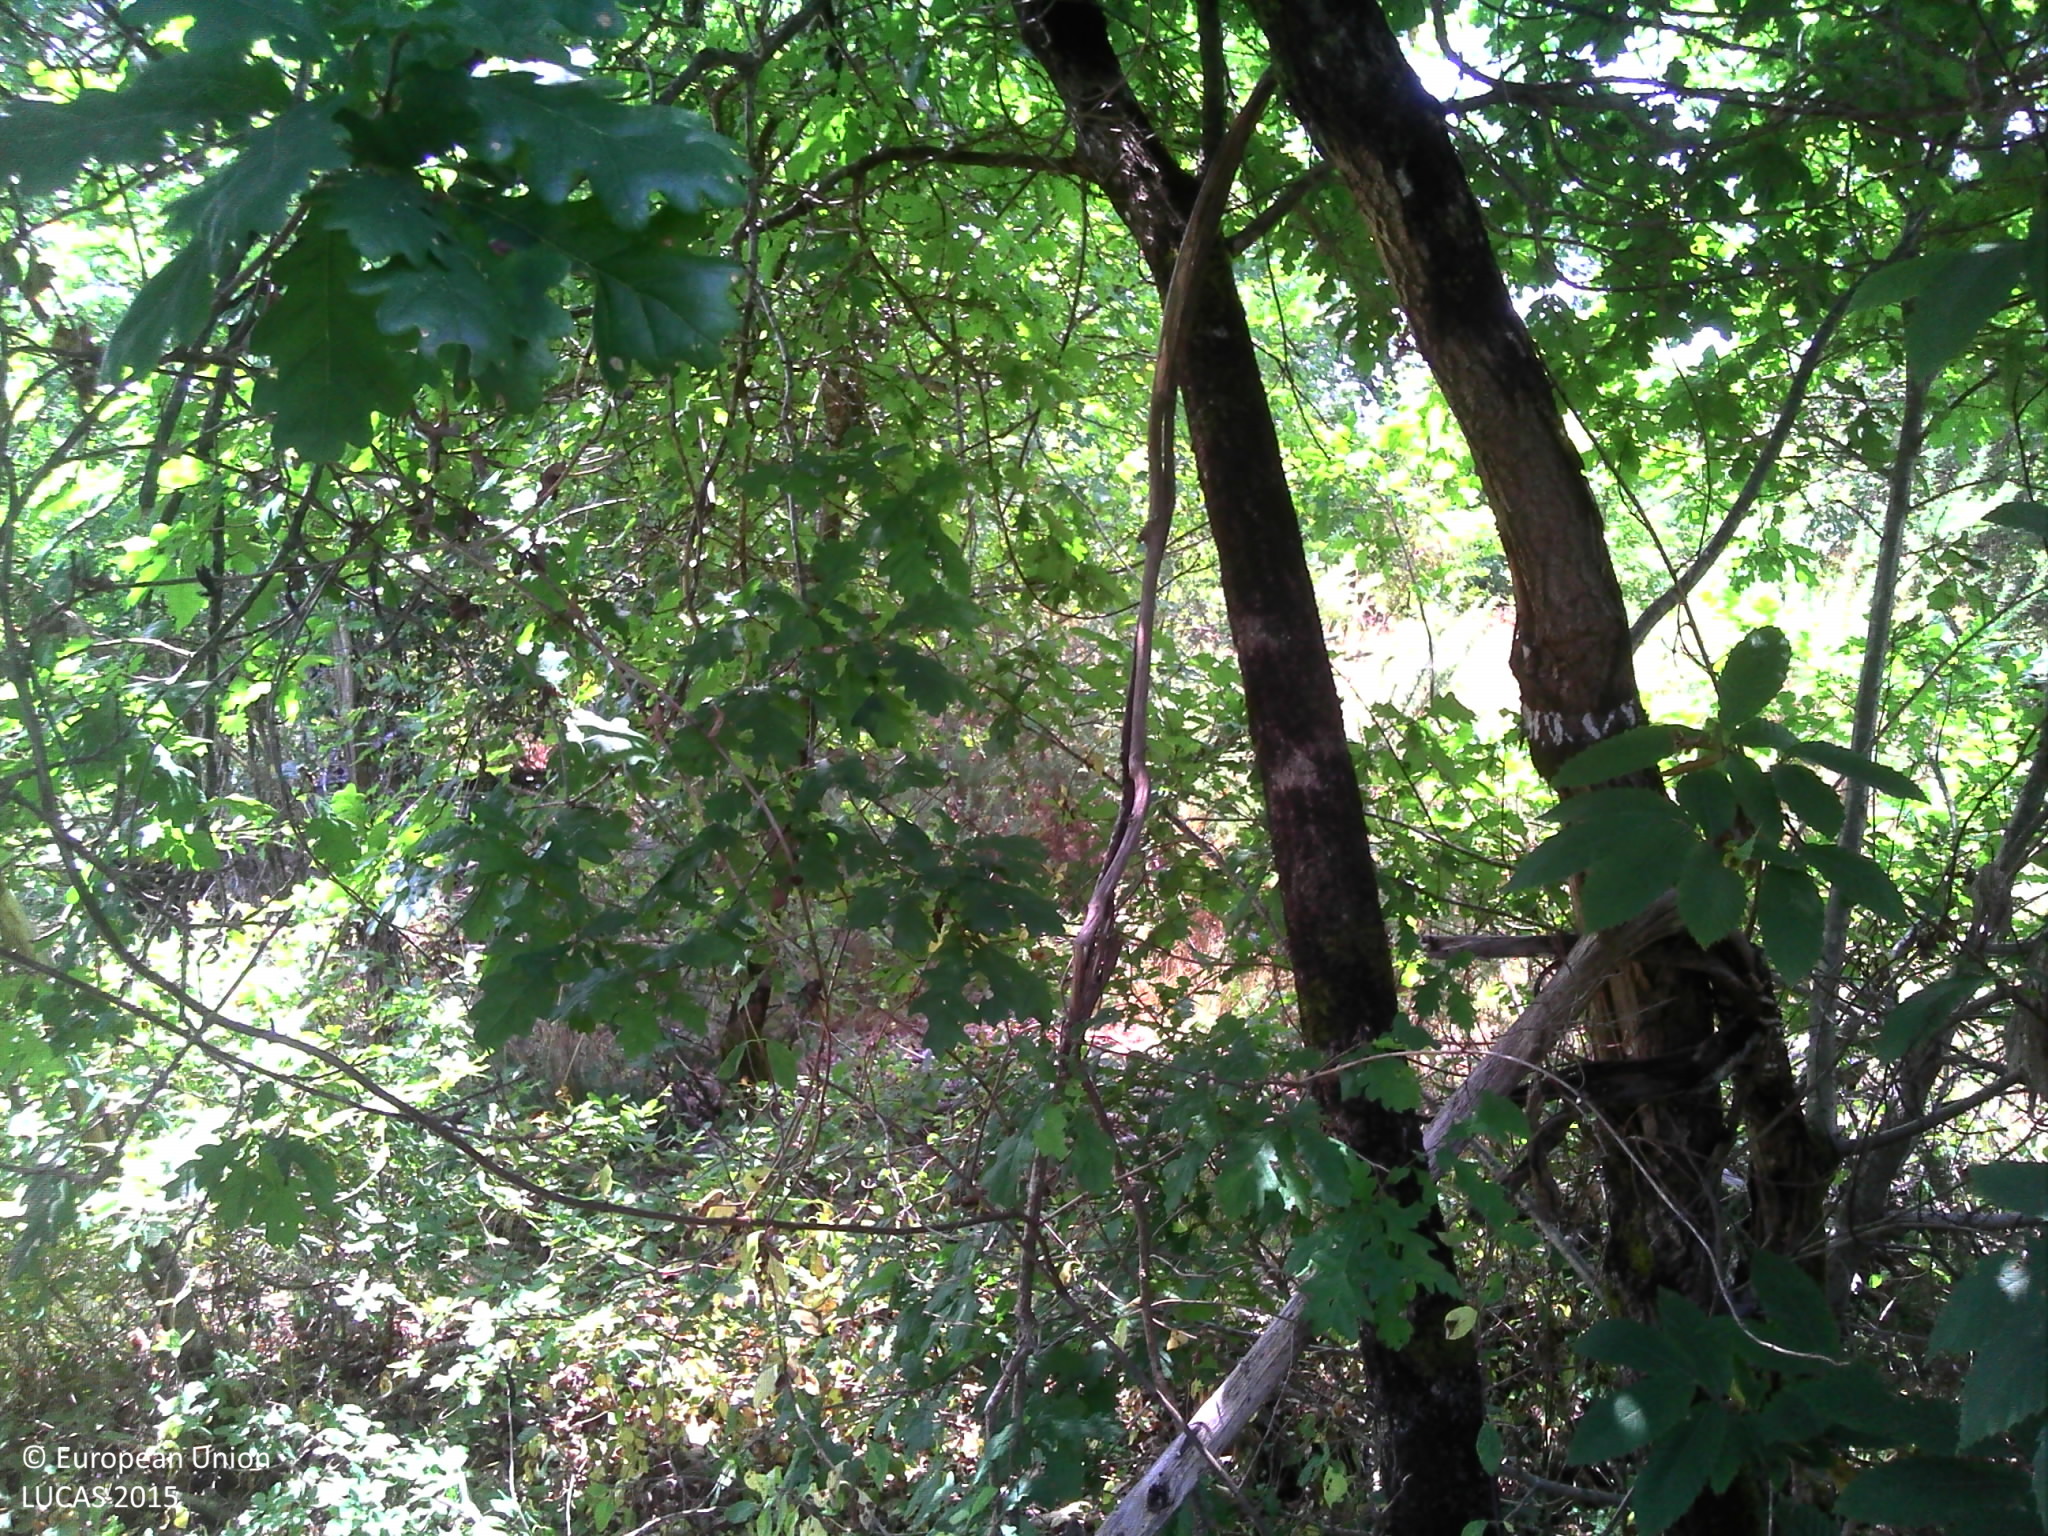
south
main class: Woodland
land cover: Broadleaved woodland
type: thermophilous deciduous forest
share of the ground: > 75 %
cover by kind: broadleaved forest trees 85 %, coniferous forest trees 5 %, shrubs 5 %, herbaceous plants 5 %
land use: Semi-natural and natural areas not in use
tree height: < 5 m
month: July
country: FR
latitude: 44.3803
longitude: -0.6727
